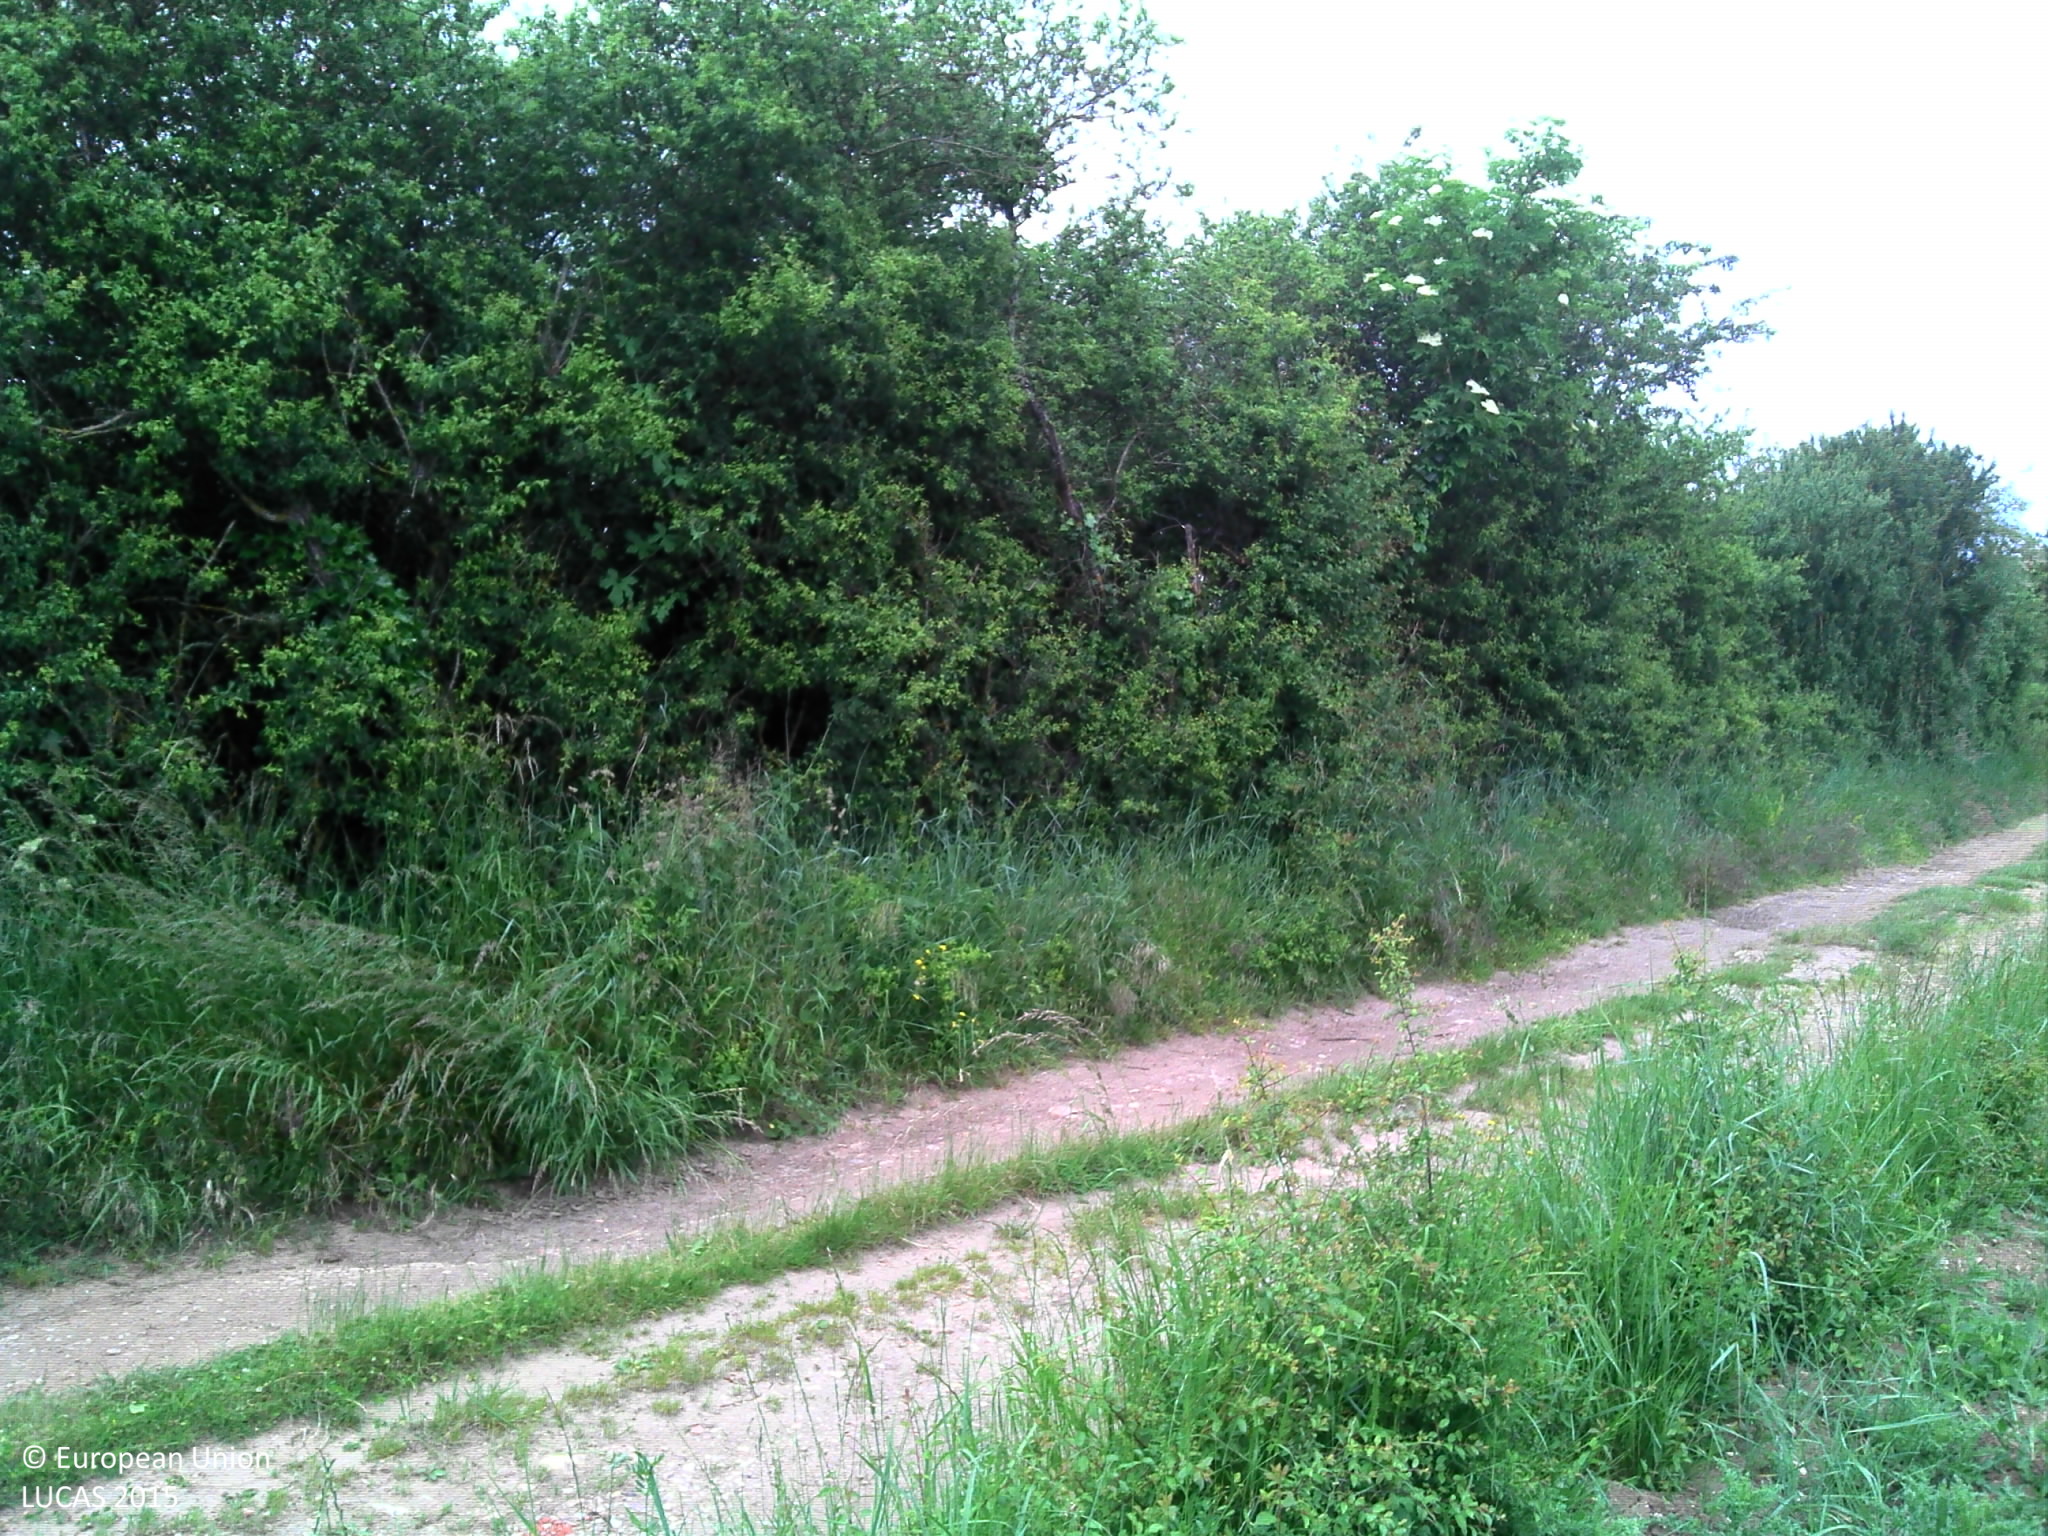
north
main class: Woodland
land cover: Broadleaved woodland
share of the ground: > 75 %
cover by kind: broadleaved forest trees 100 %
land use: Semi-natural and natural areas not in use
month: May
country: FR
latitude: 47.3415
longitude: 2.8601
